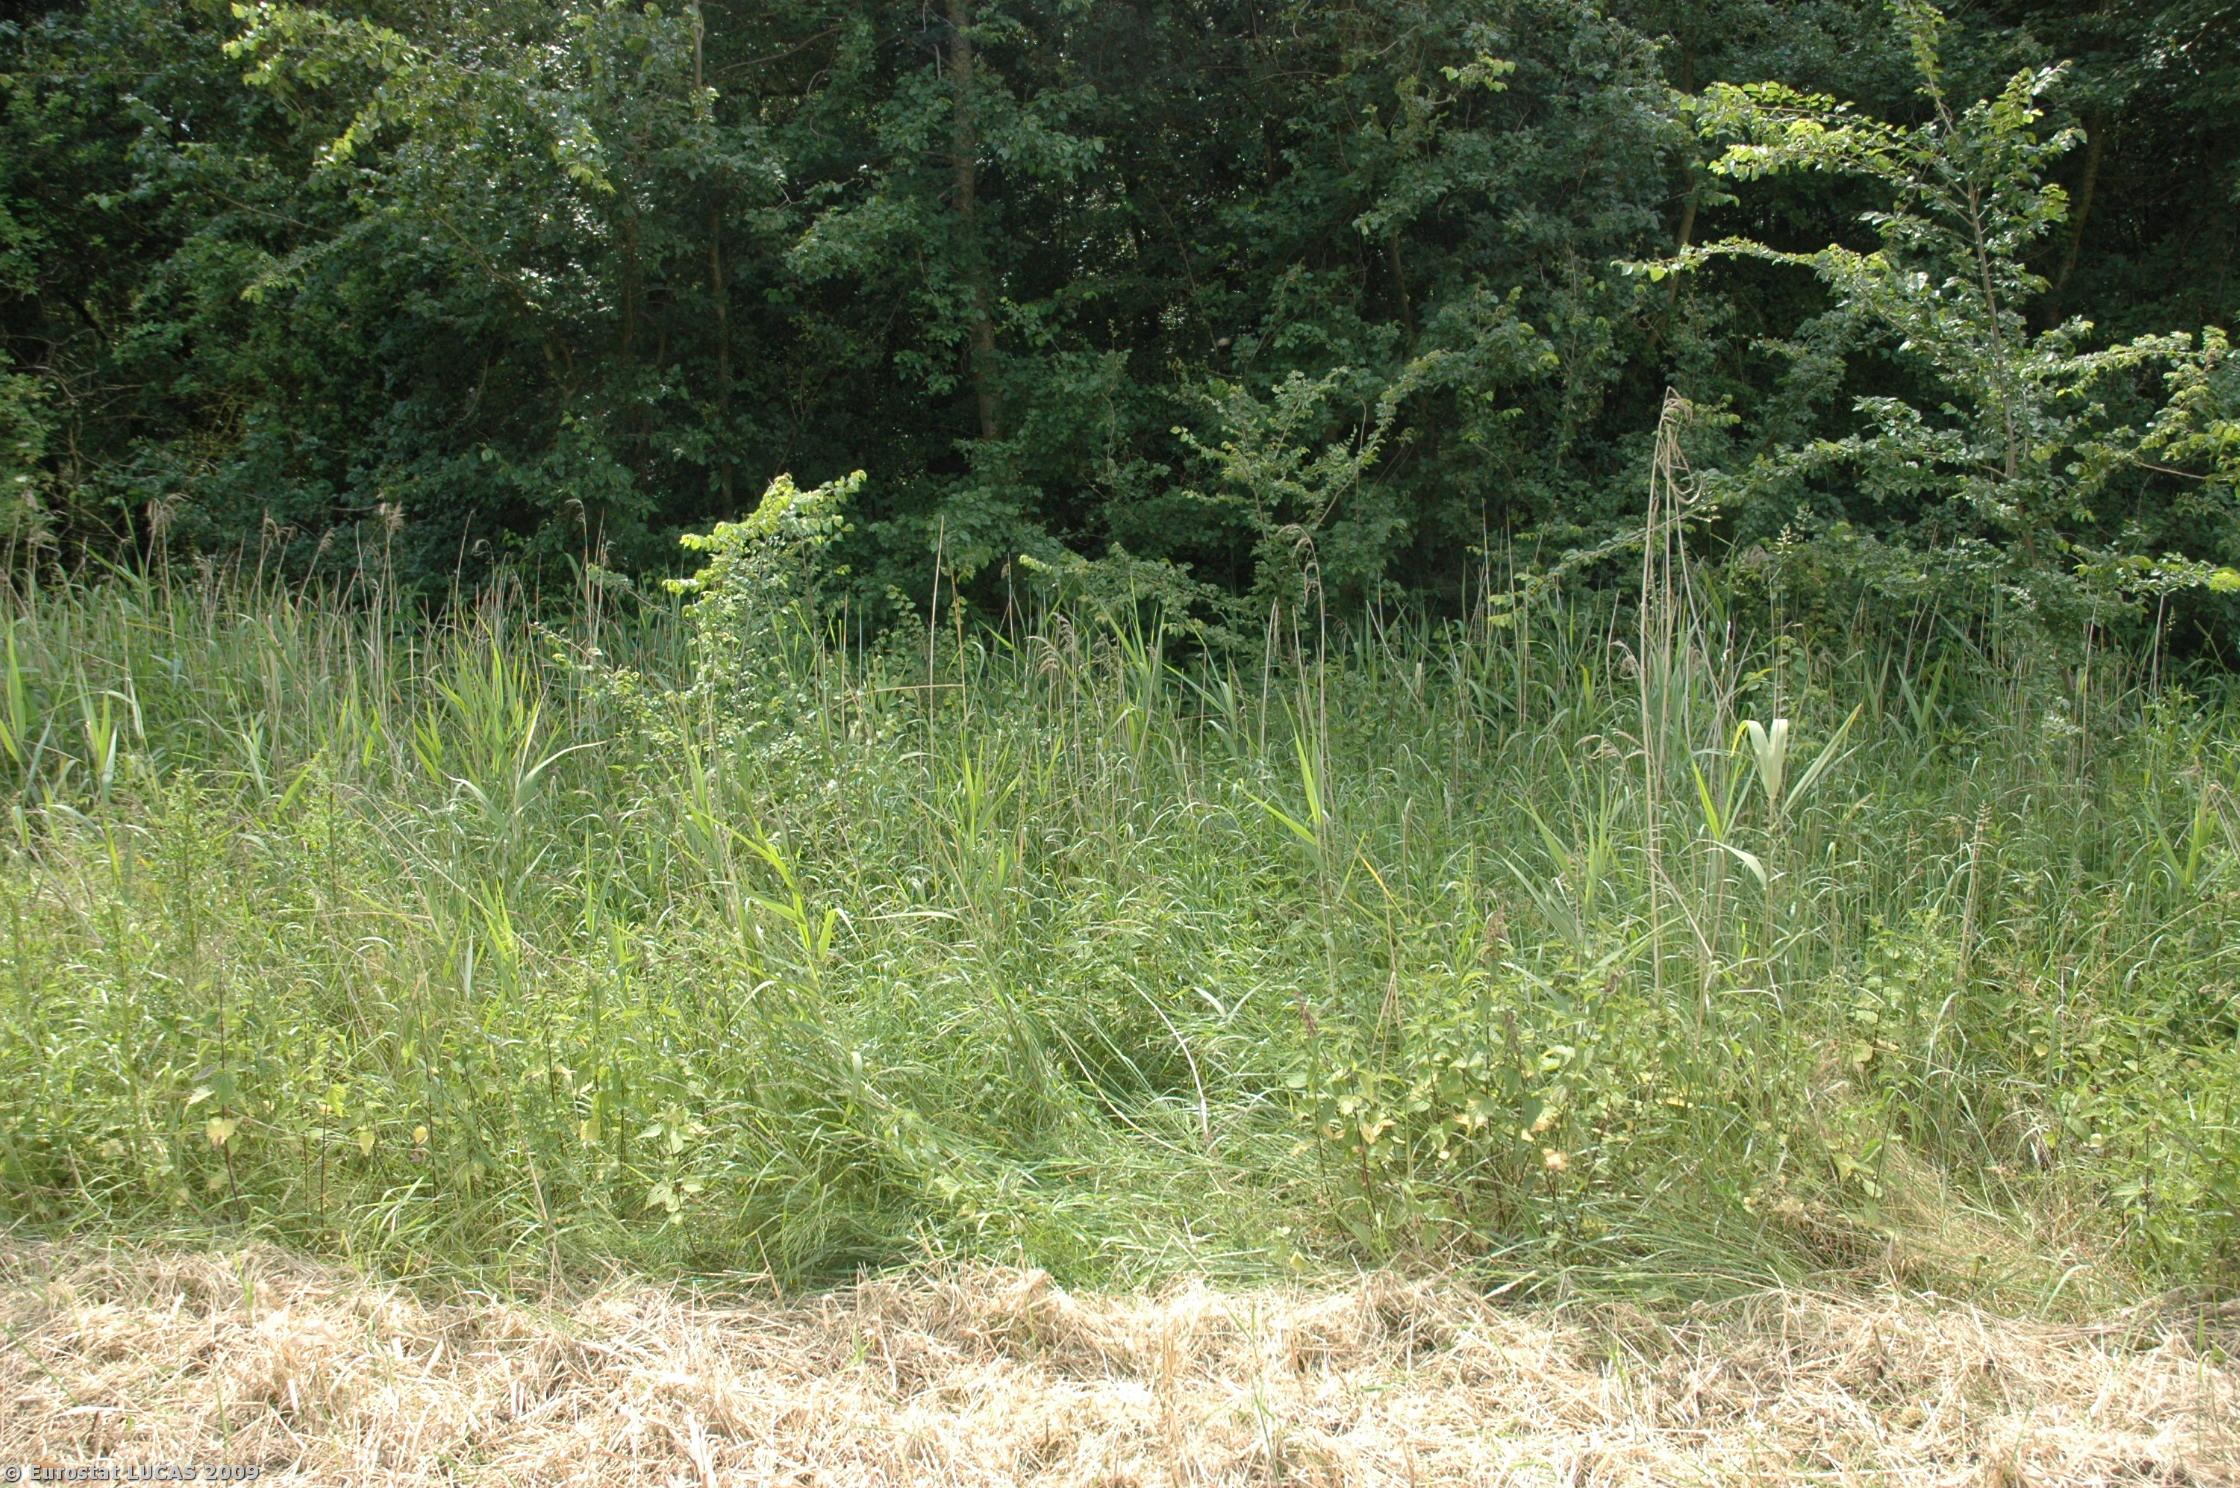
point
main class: Woodland
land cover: Broadleaved woodland
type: non-riverine alder, birch or aspen forest
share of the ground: > 75 %
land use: Unused
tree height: > 5 m
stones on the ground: < 10 %
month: June
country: NL
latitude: 52.6036
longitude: 5.6429
